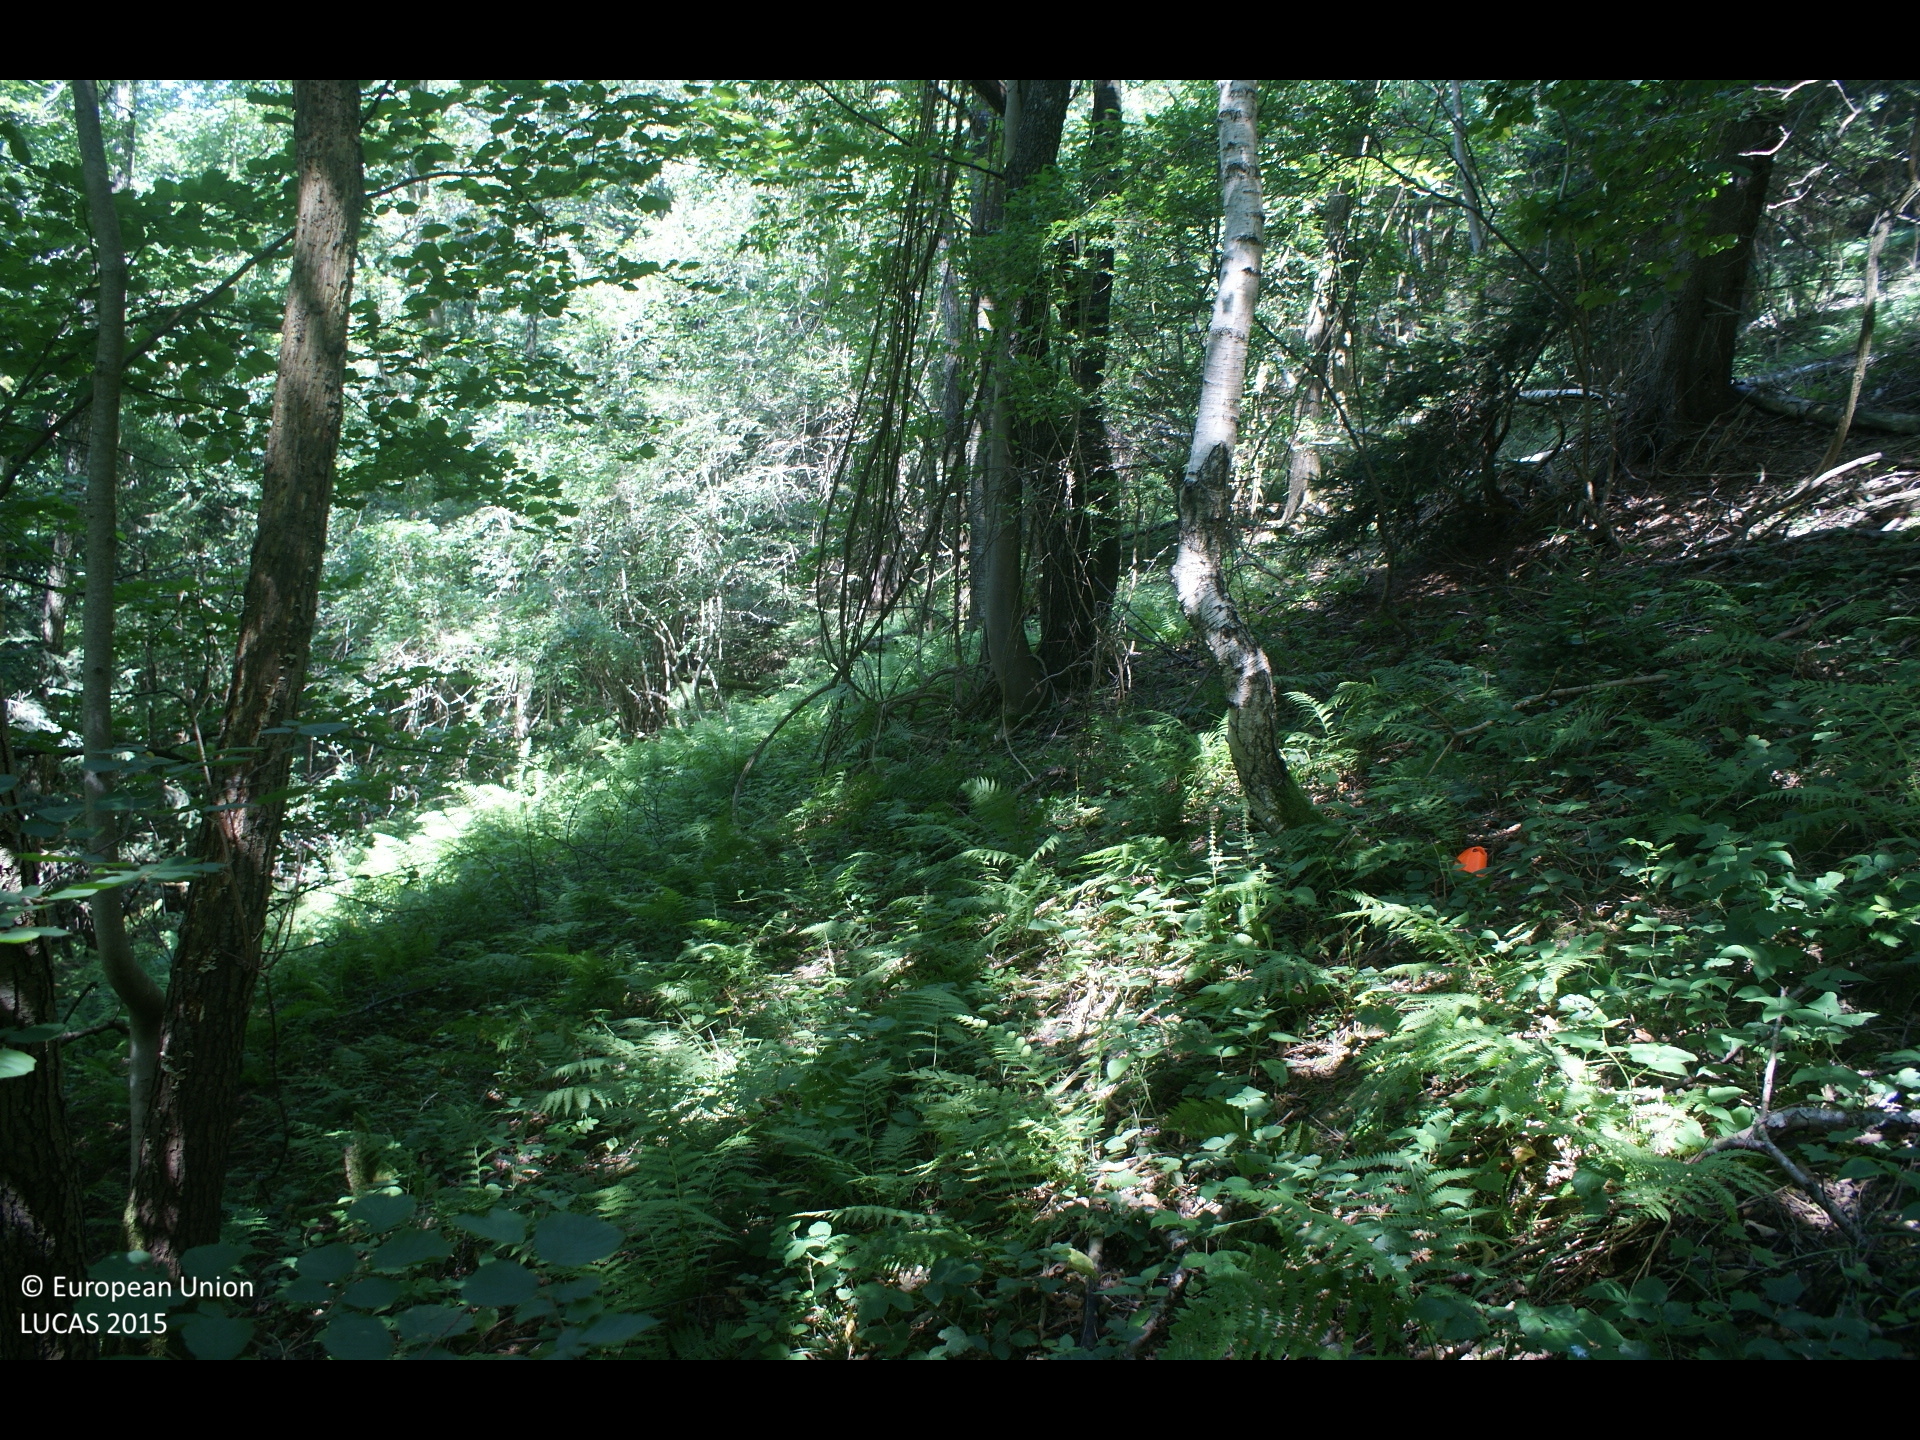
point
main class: Woodland
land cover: Broadleaved woodland
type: mesophytic deciduous forest
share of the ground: > 75 %
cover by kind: broadleaved forest trees 75 %, coniferous forest trees 20 %, herbaceous plants 5 %
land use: Forestry
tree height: > 5 m
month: July
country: AT
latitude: 48.0044
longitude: 14.9467
